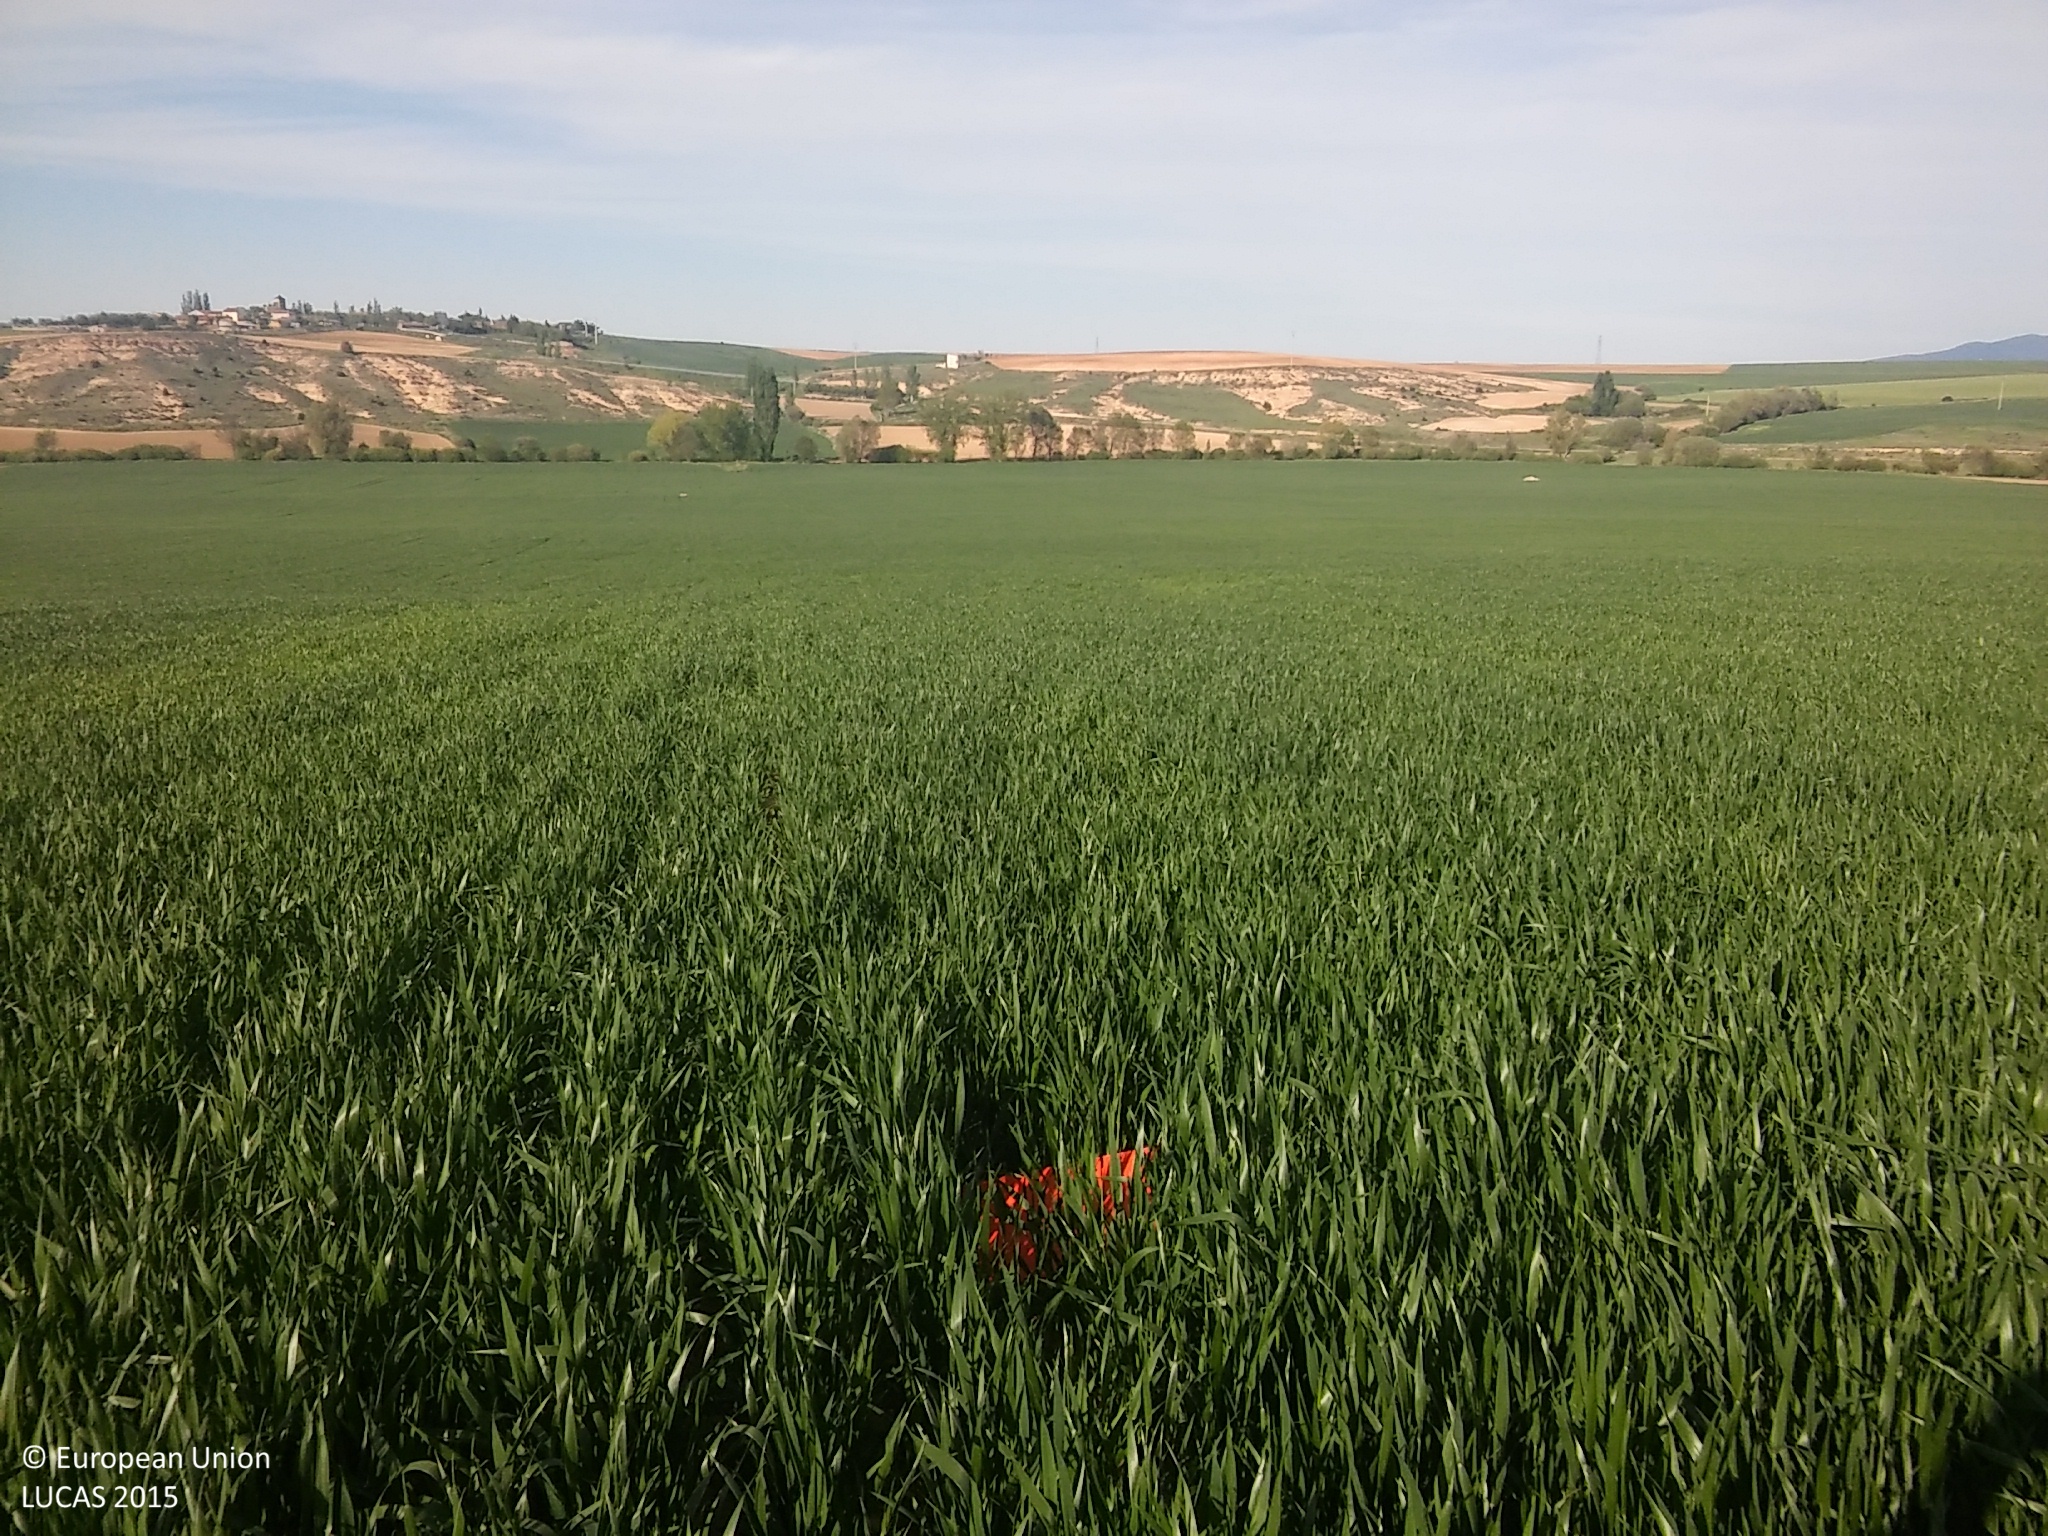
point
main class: Cropland
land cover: Common wheat
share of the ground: > 75 %
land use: Agriculture (excluding fallow land and kitchen gardens)
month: May
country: ES
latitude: 41.2588
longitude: -3.7141
